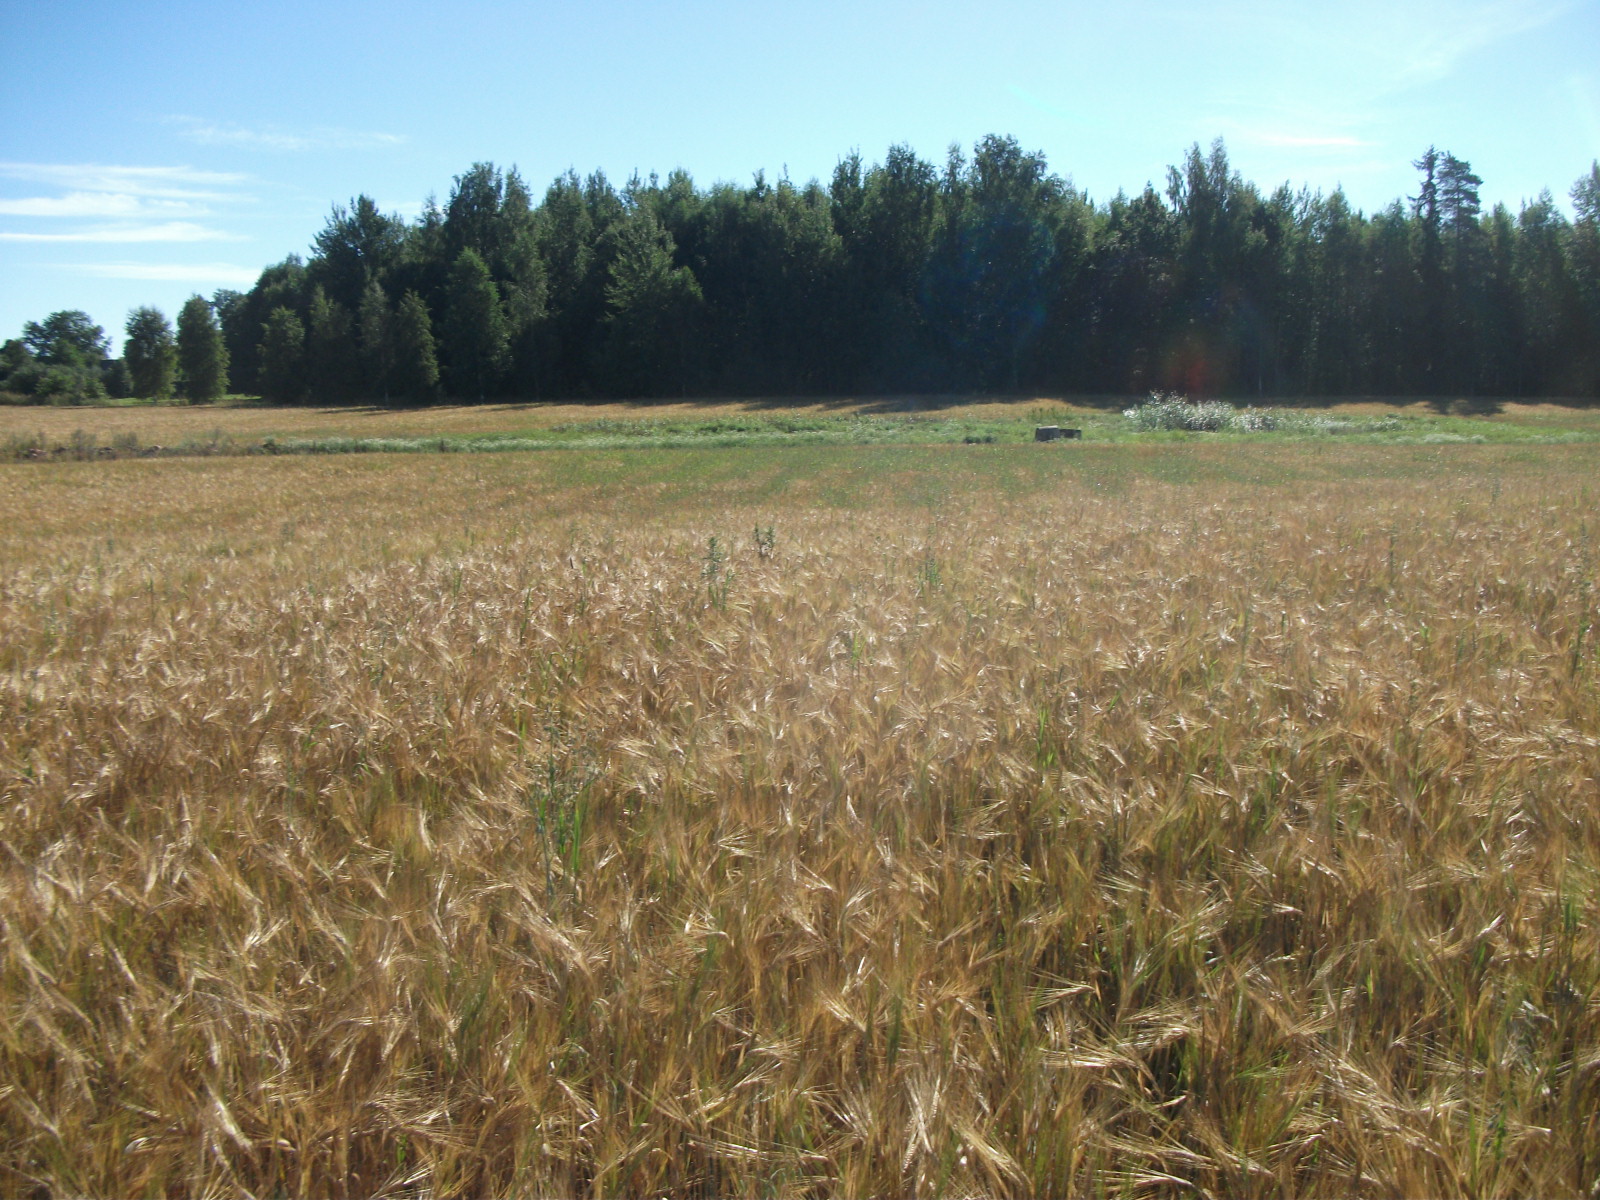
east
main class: Cropland
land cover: Barley
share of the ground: > 75 %
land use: Agriculture (excluding fallow land and kitchen gardens)
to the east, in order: Barley; Spontaneously vegetated surfaces; Barley; Broadleaved woodland
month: August
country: LV
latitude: 56.7128
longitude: 26.3319
